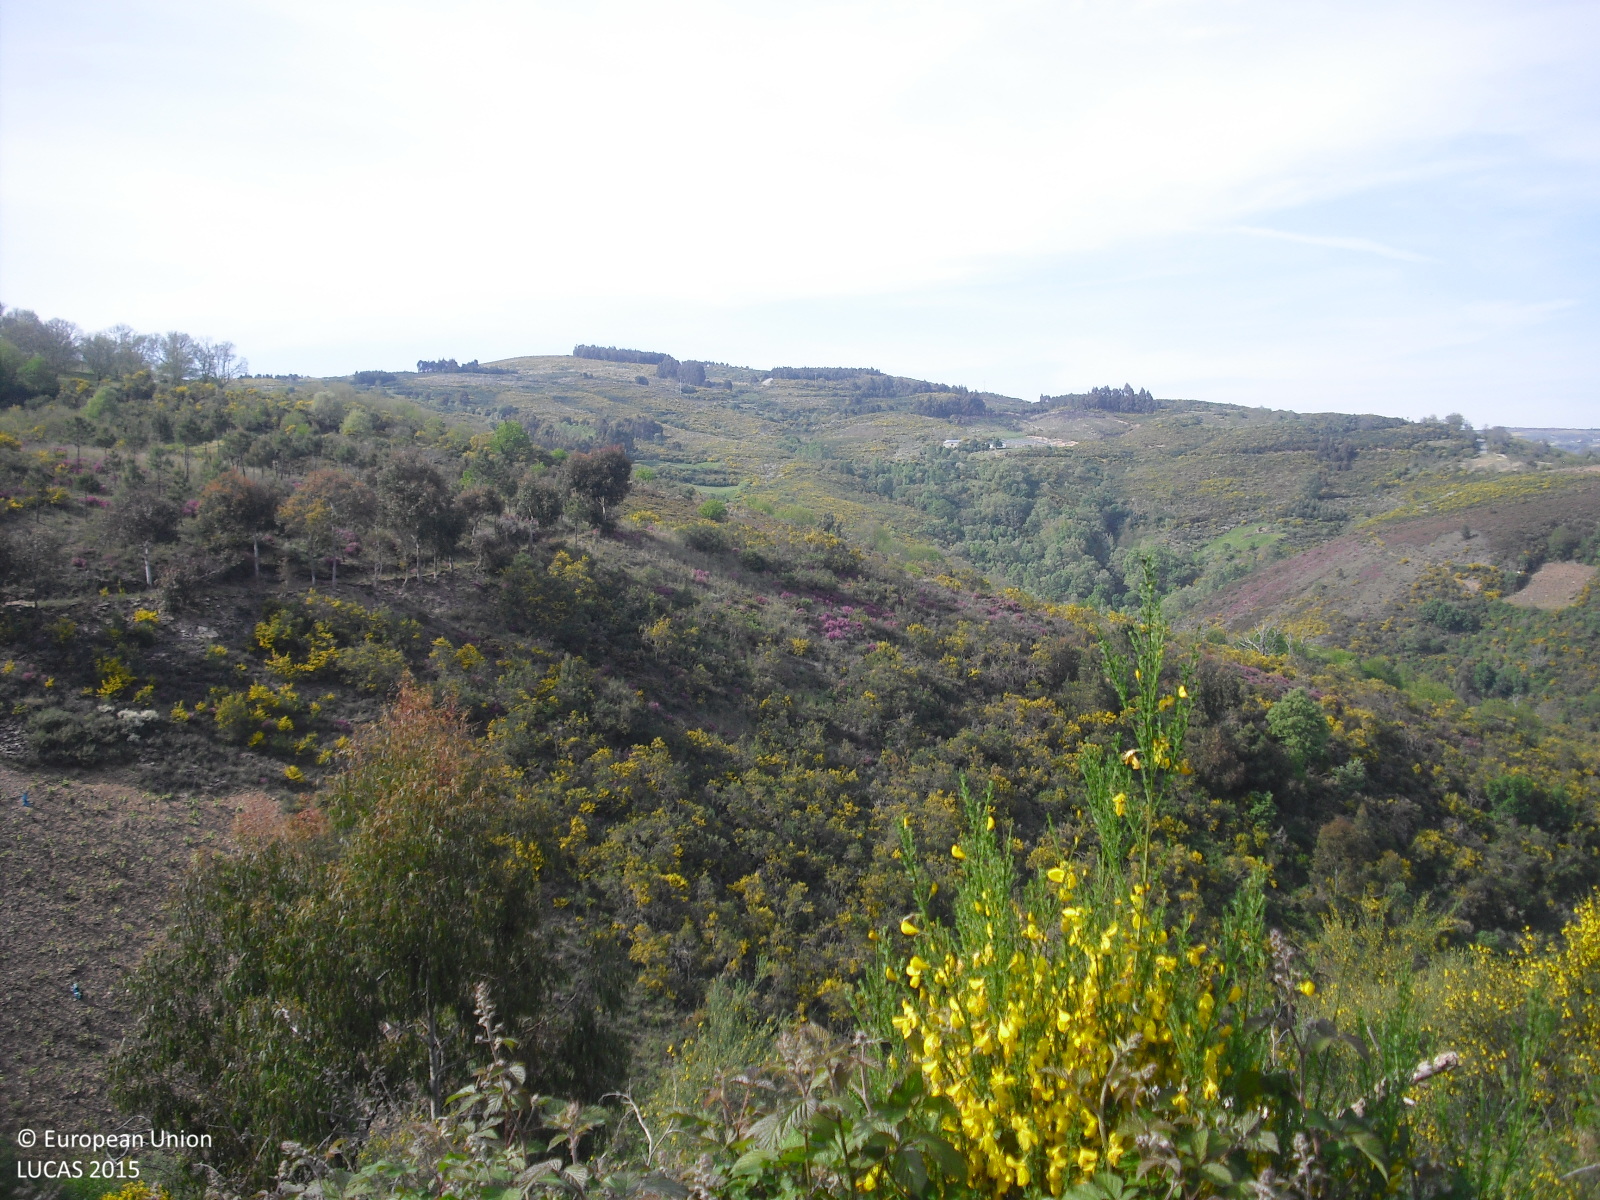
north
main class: Shrubland
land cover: Shrubland without tree cover
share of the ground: > 75 %
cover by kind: shrubs 100 %
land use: Semi-natural and natural areas not in use
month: May
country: ES
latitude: 41.8754
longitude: -7.2732
